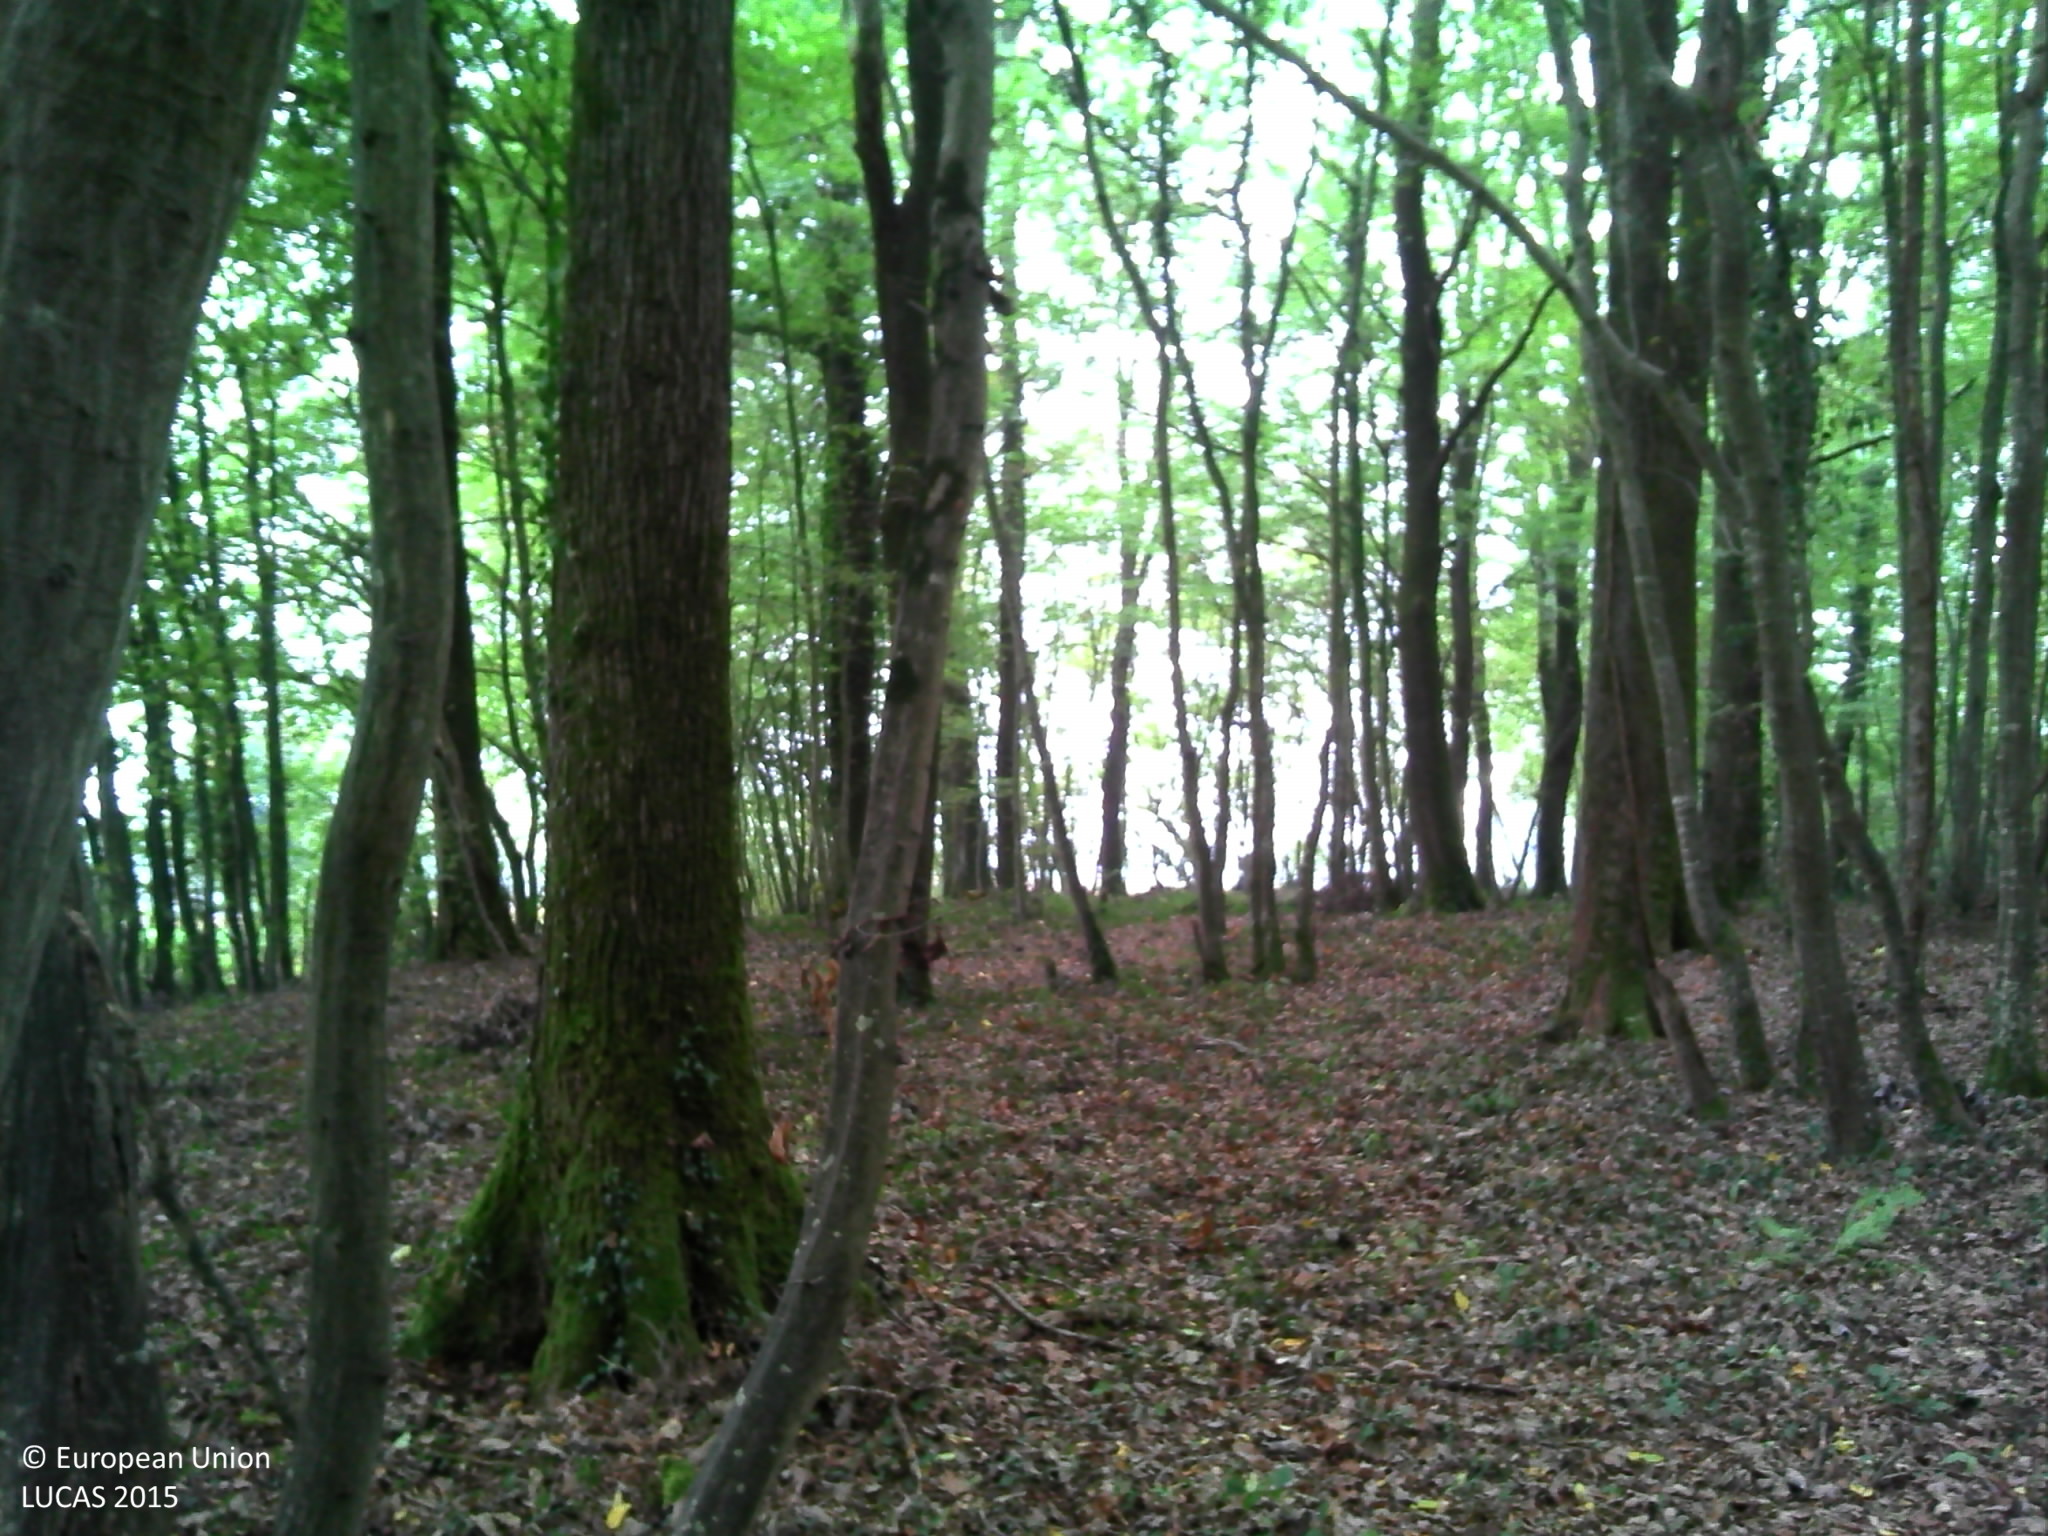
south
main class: Woodland
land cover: Broadleaved woodland
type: mesophytic deciduous forest
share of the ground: > 75 %
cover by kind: broadleaved forest trees 95 %, herbaceous plants 5 %
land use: Forestry
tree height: > 5 m
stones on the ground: < 10 %
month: October
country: FR
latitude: 46.2587
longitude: 5.1379
